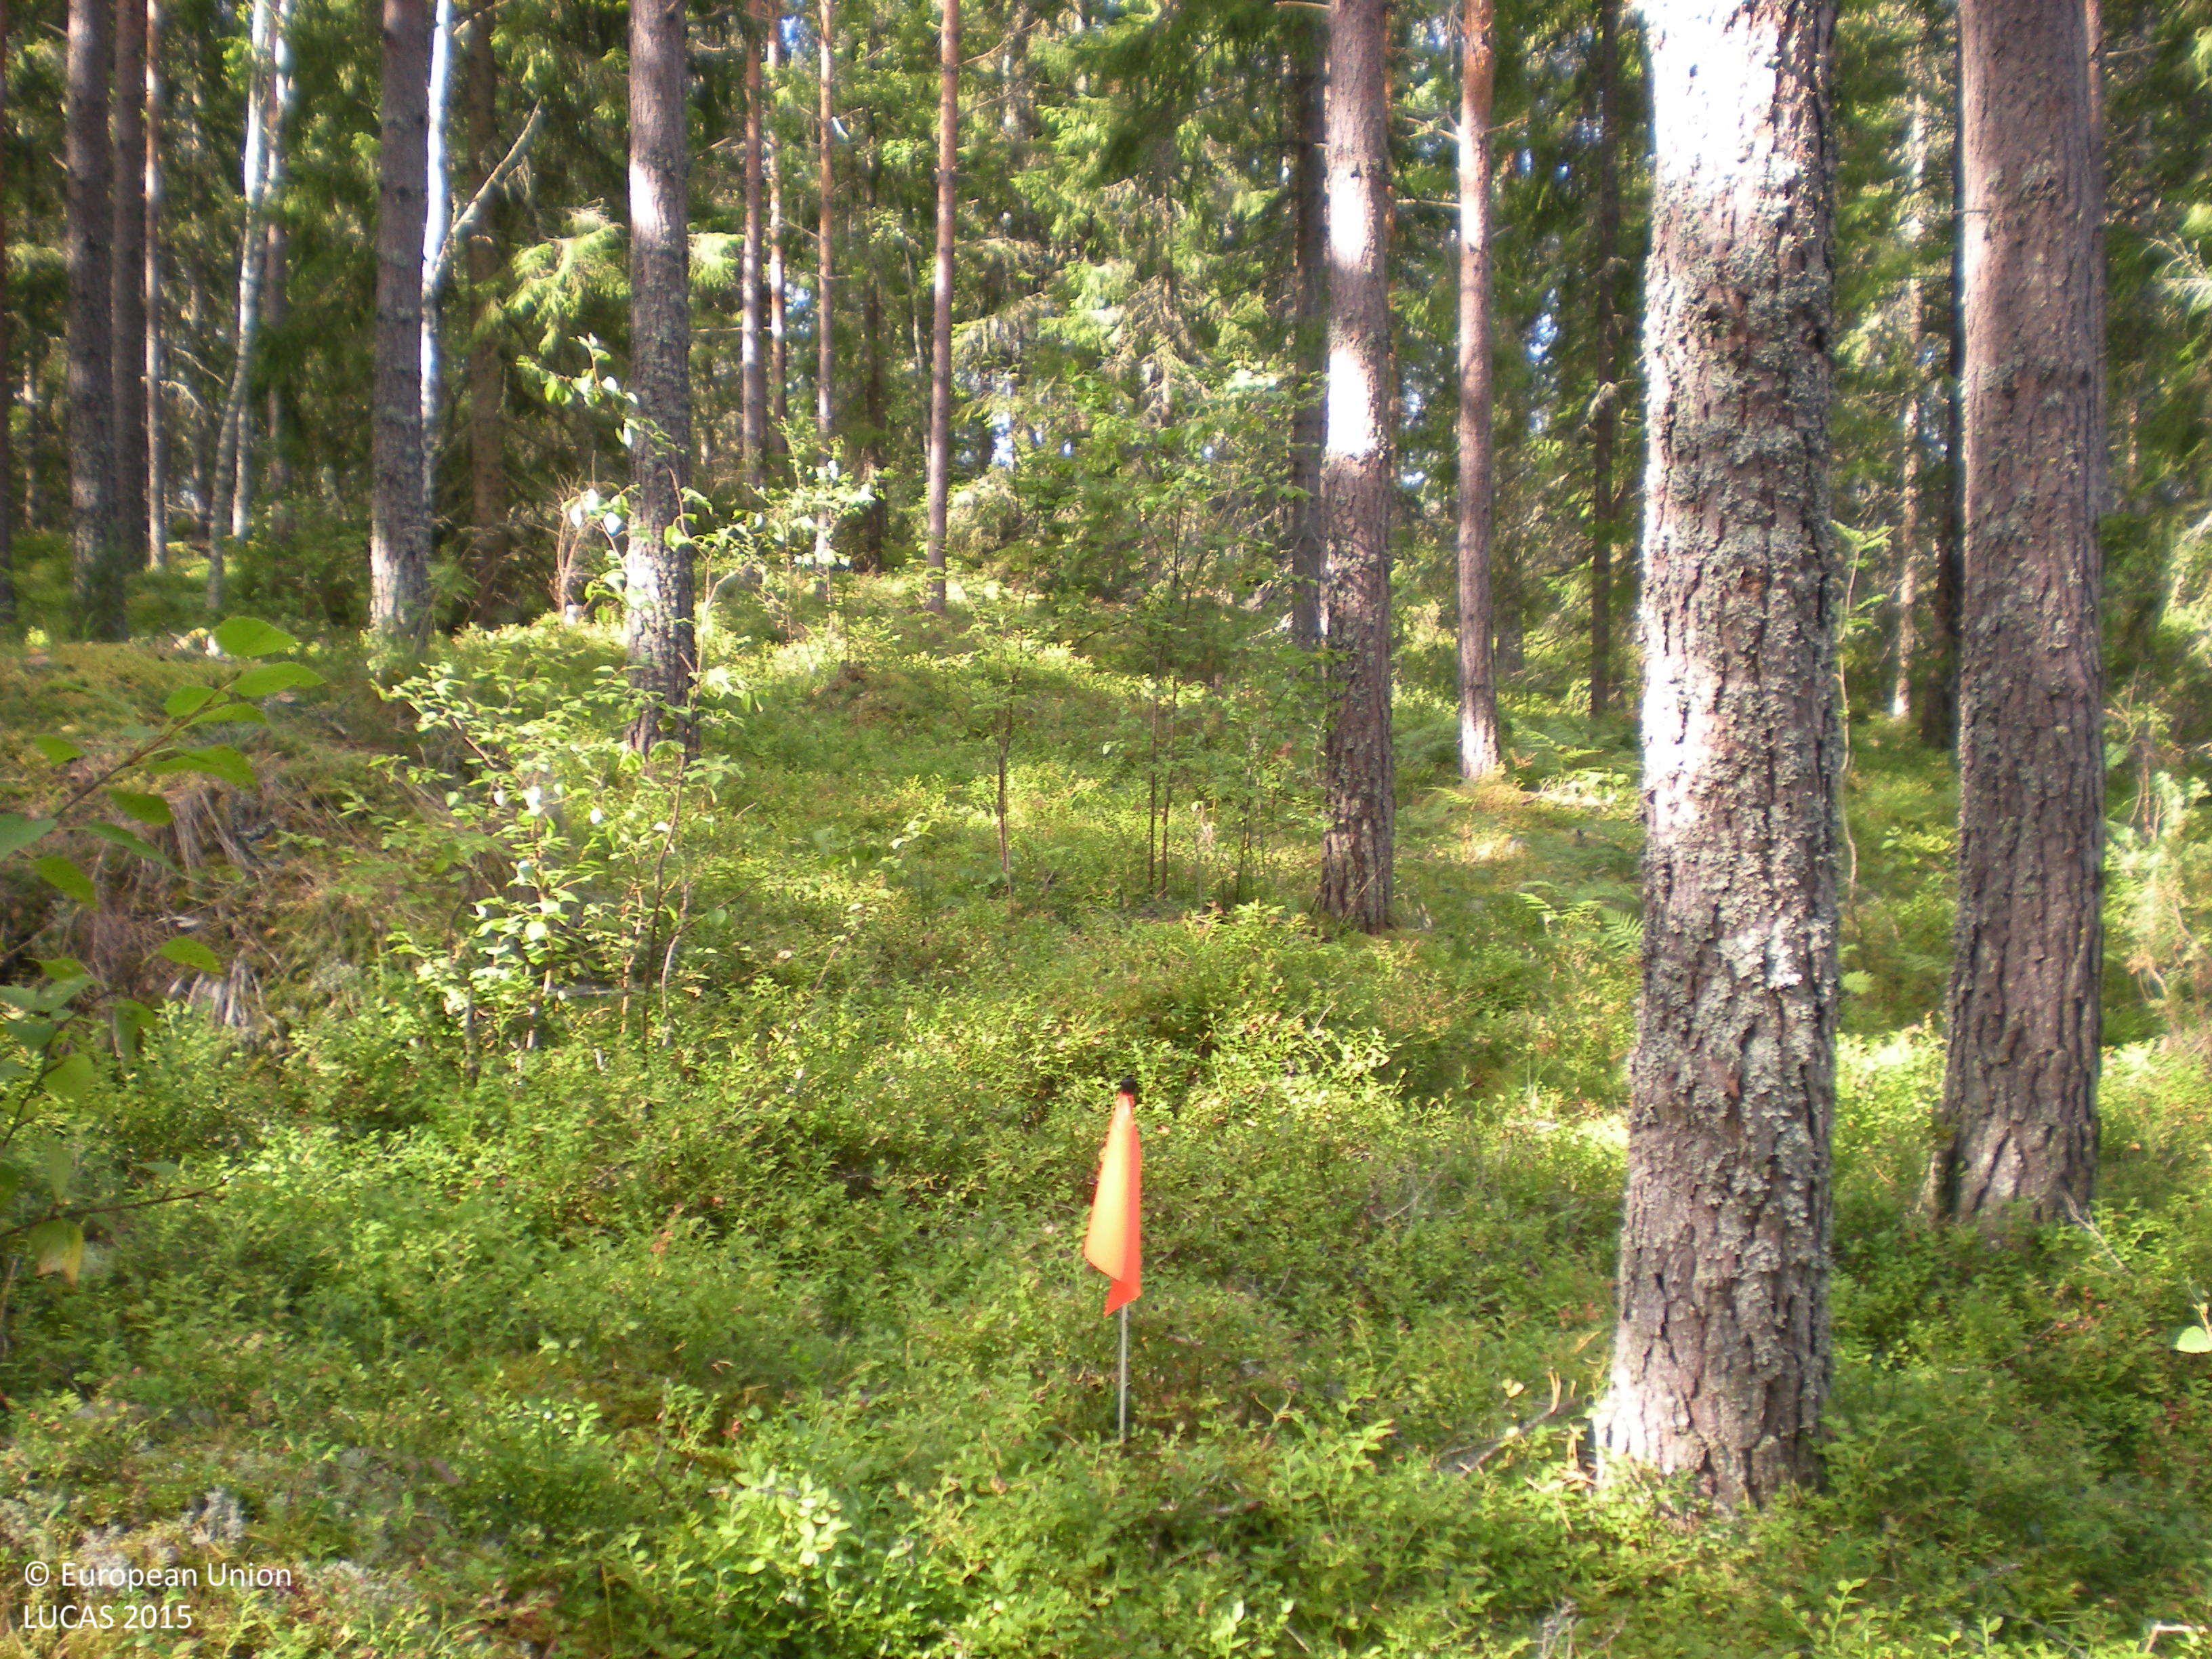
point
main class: Woodland
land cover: Other coniferous woodland
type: boreal forest
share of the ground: 50 - 75 %
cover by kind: coniferous forest trees 70 %, shrubs 20 %, broadleaved forest trees 5 %, lichens and mosses 5 %
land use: Forestry
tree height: > 5 m
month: August
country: SE
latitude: 60.4379
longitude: 17.0584
